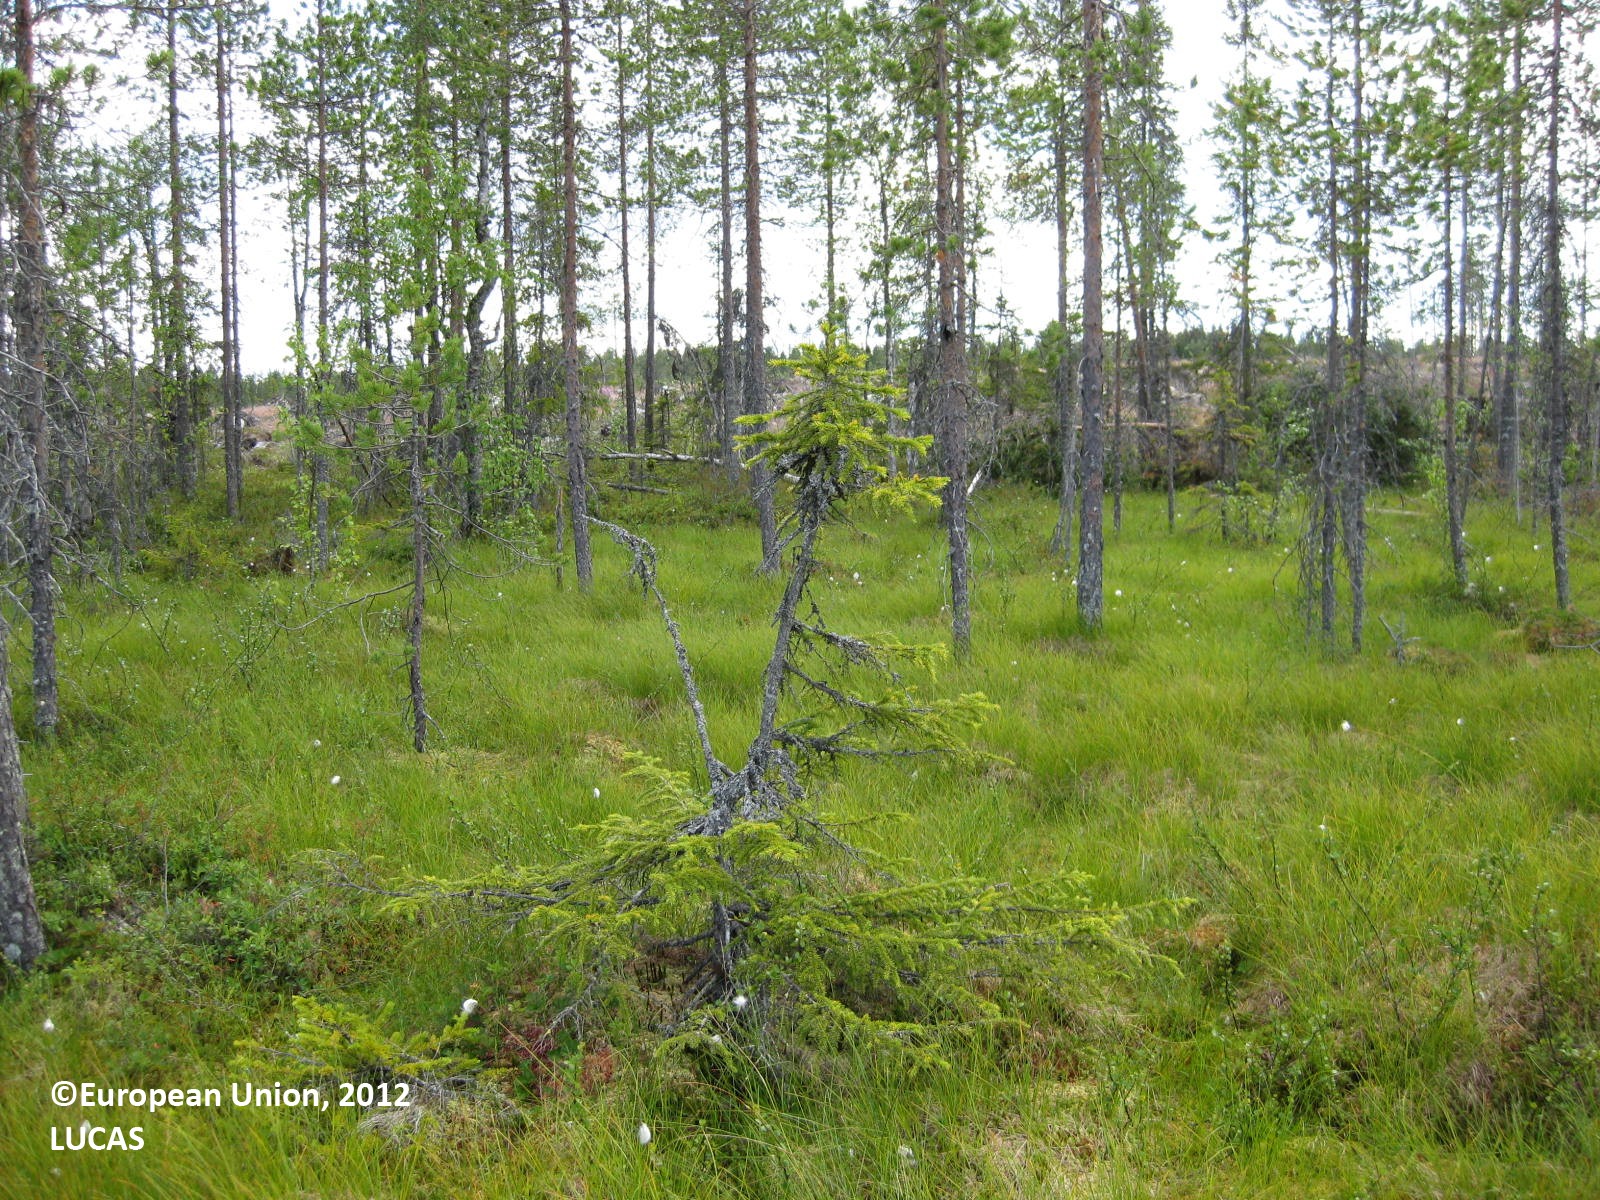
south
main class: Woodland
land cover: Pine dominated coniferous woodland
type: boreal forest
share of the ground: 25 - 50 %
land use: Semi-natural and natural areas not in use
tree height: > 5 m
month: July
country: FI
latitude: 65.7553
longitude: 28.5577
